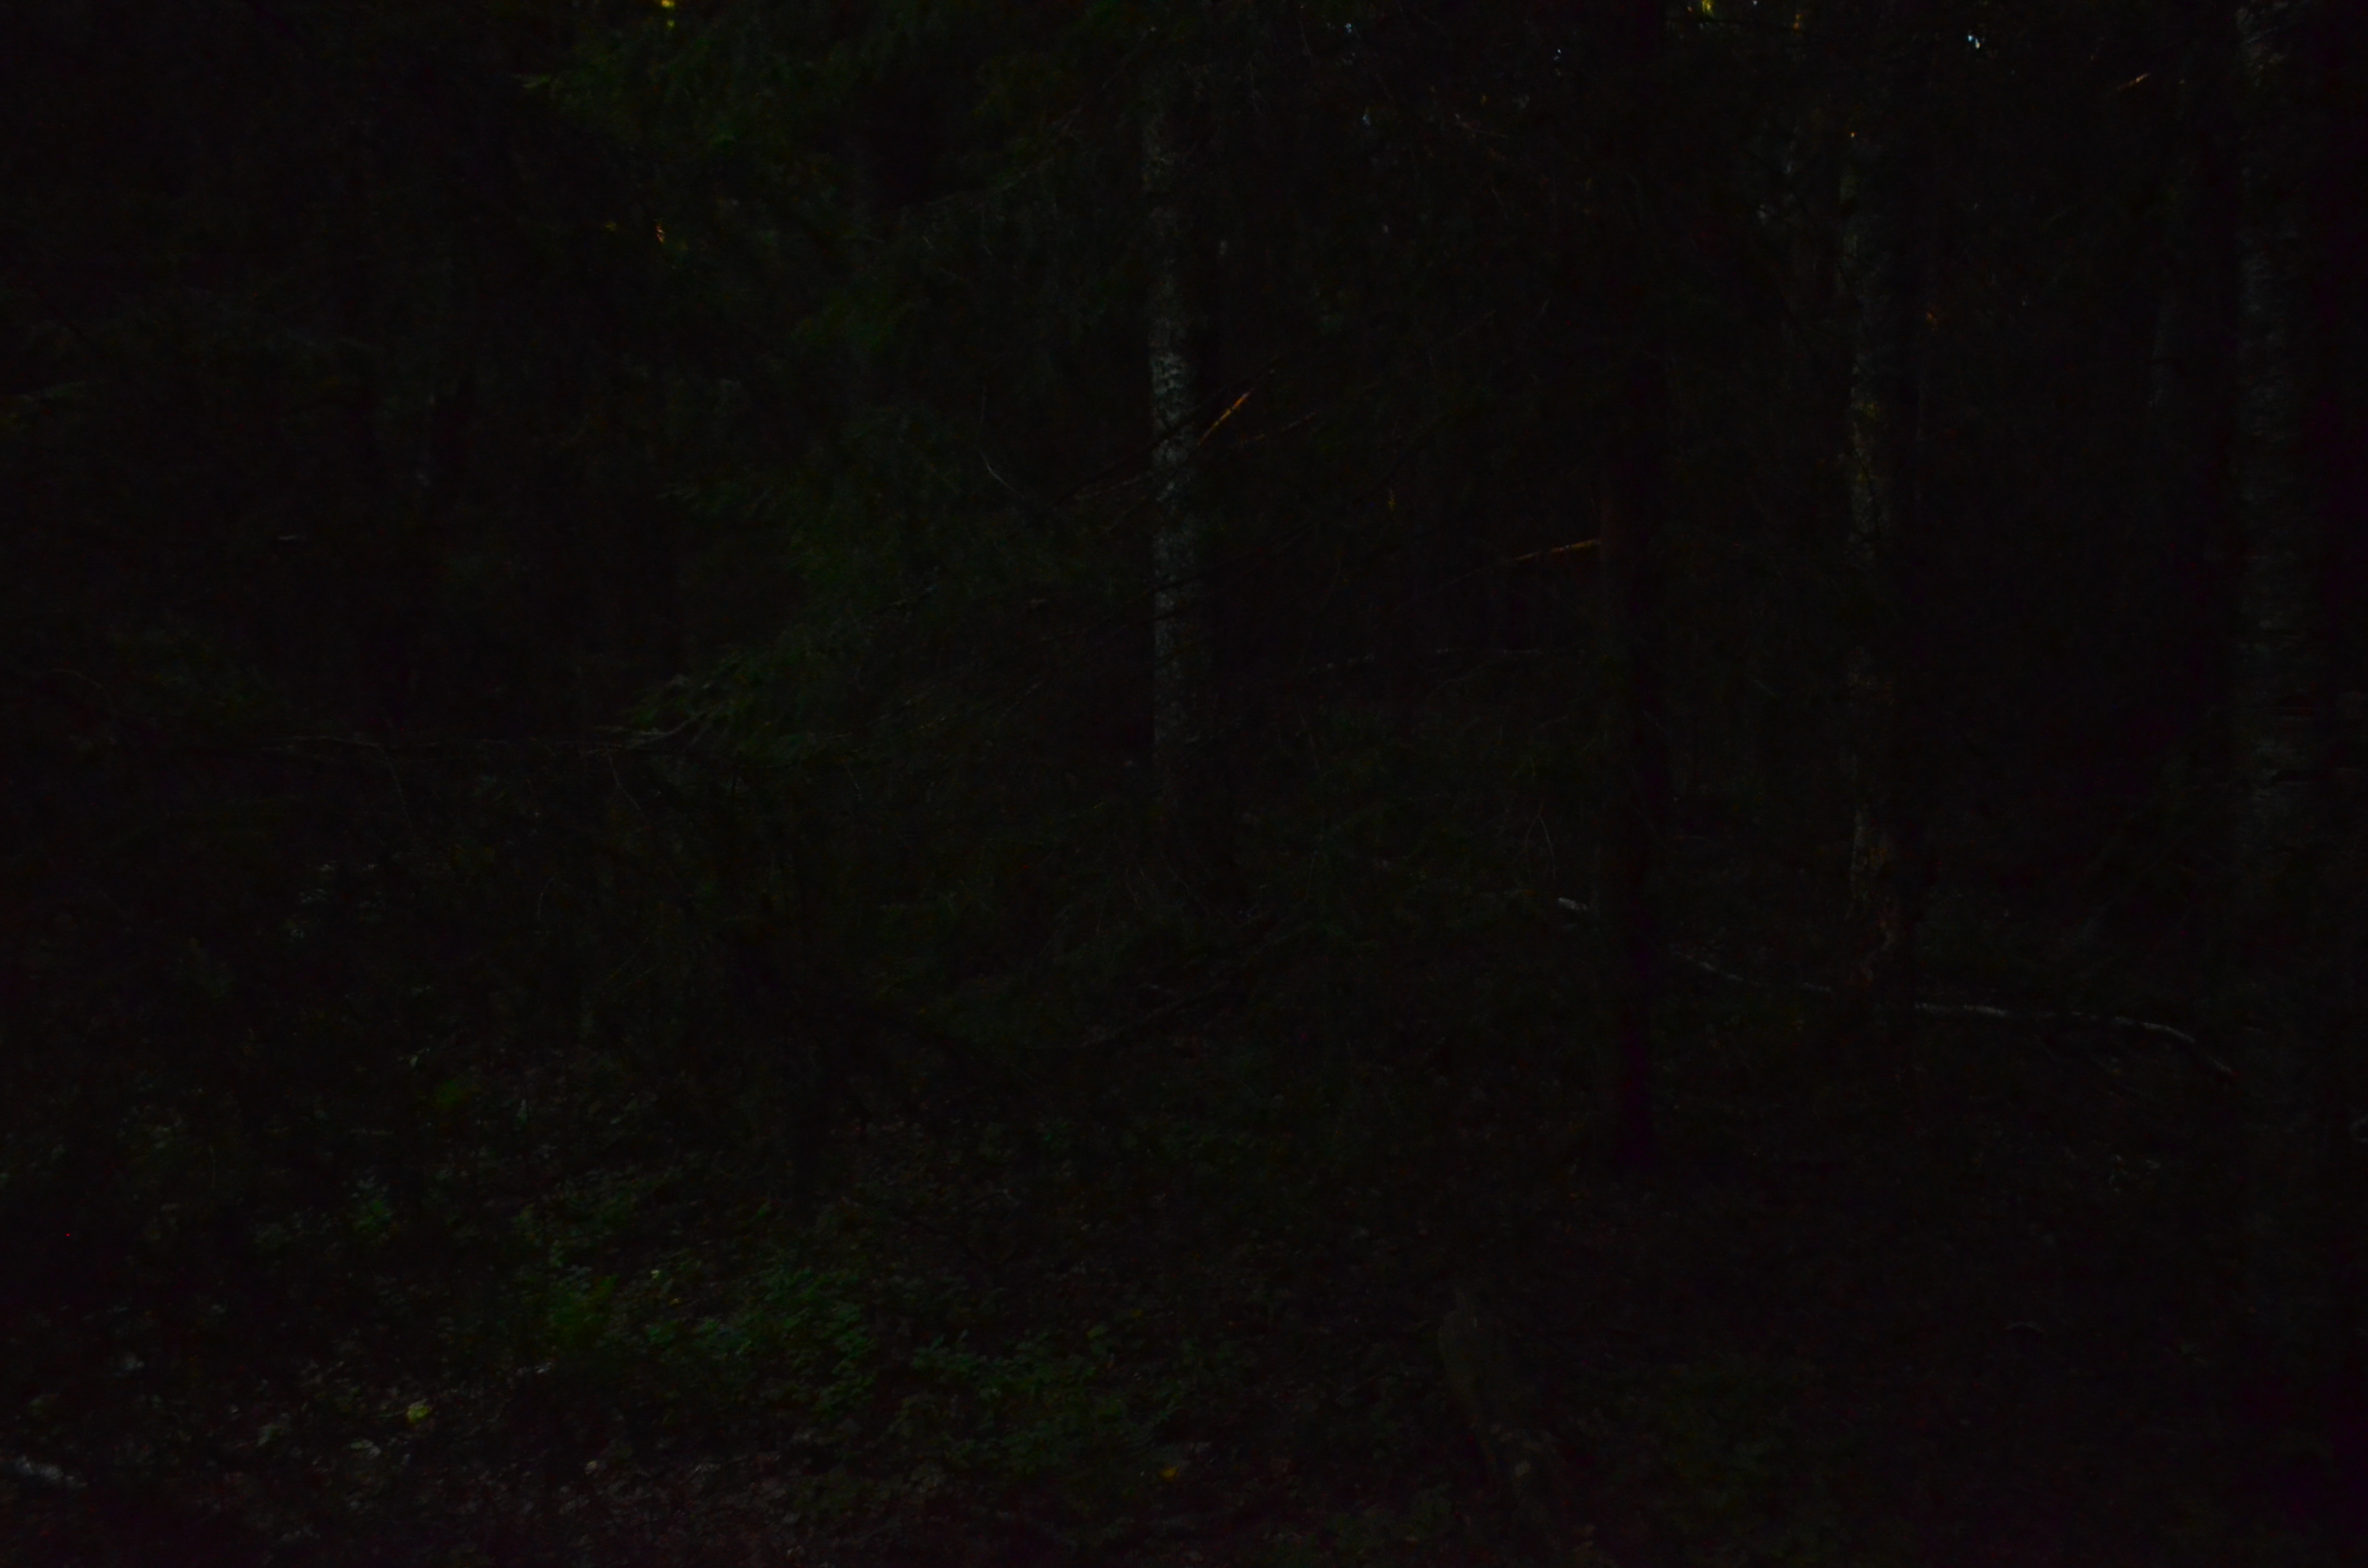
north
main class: Woodland
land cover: Other mixed woodland
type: hemiboreal forest and nemoral coniferous forest and mixed broadleaved-coniferous forest
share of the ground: > 75 %
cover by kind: coniferous forest trees 40 %, broadleaved forest trees 40 %, shrubs 10 %, herbaceous plants 10 %
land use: Forestry
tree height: > 5 m
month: August
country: LV
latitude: 57.5085
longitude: 21.6740
